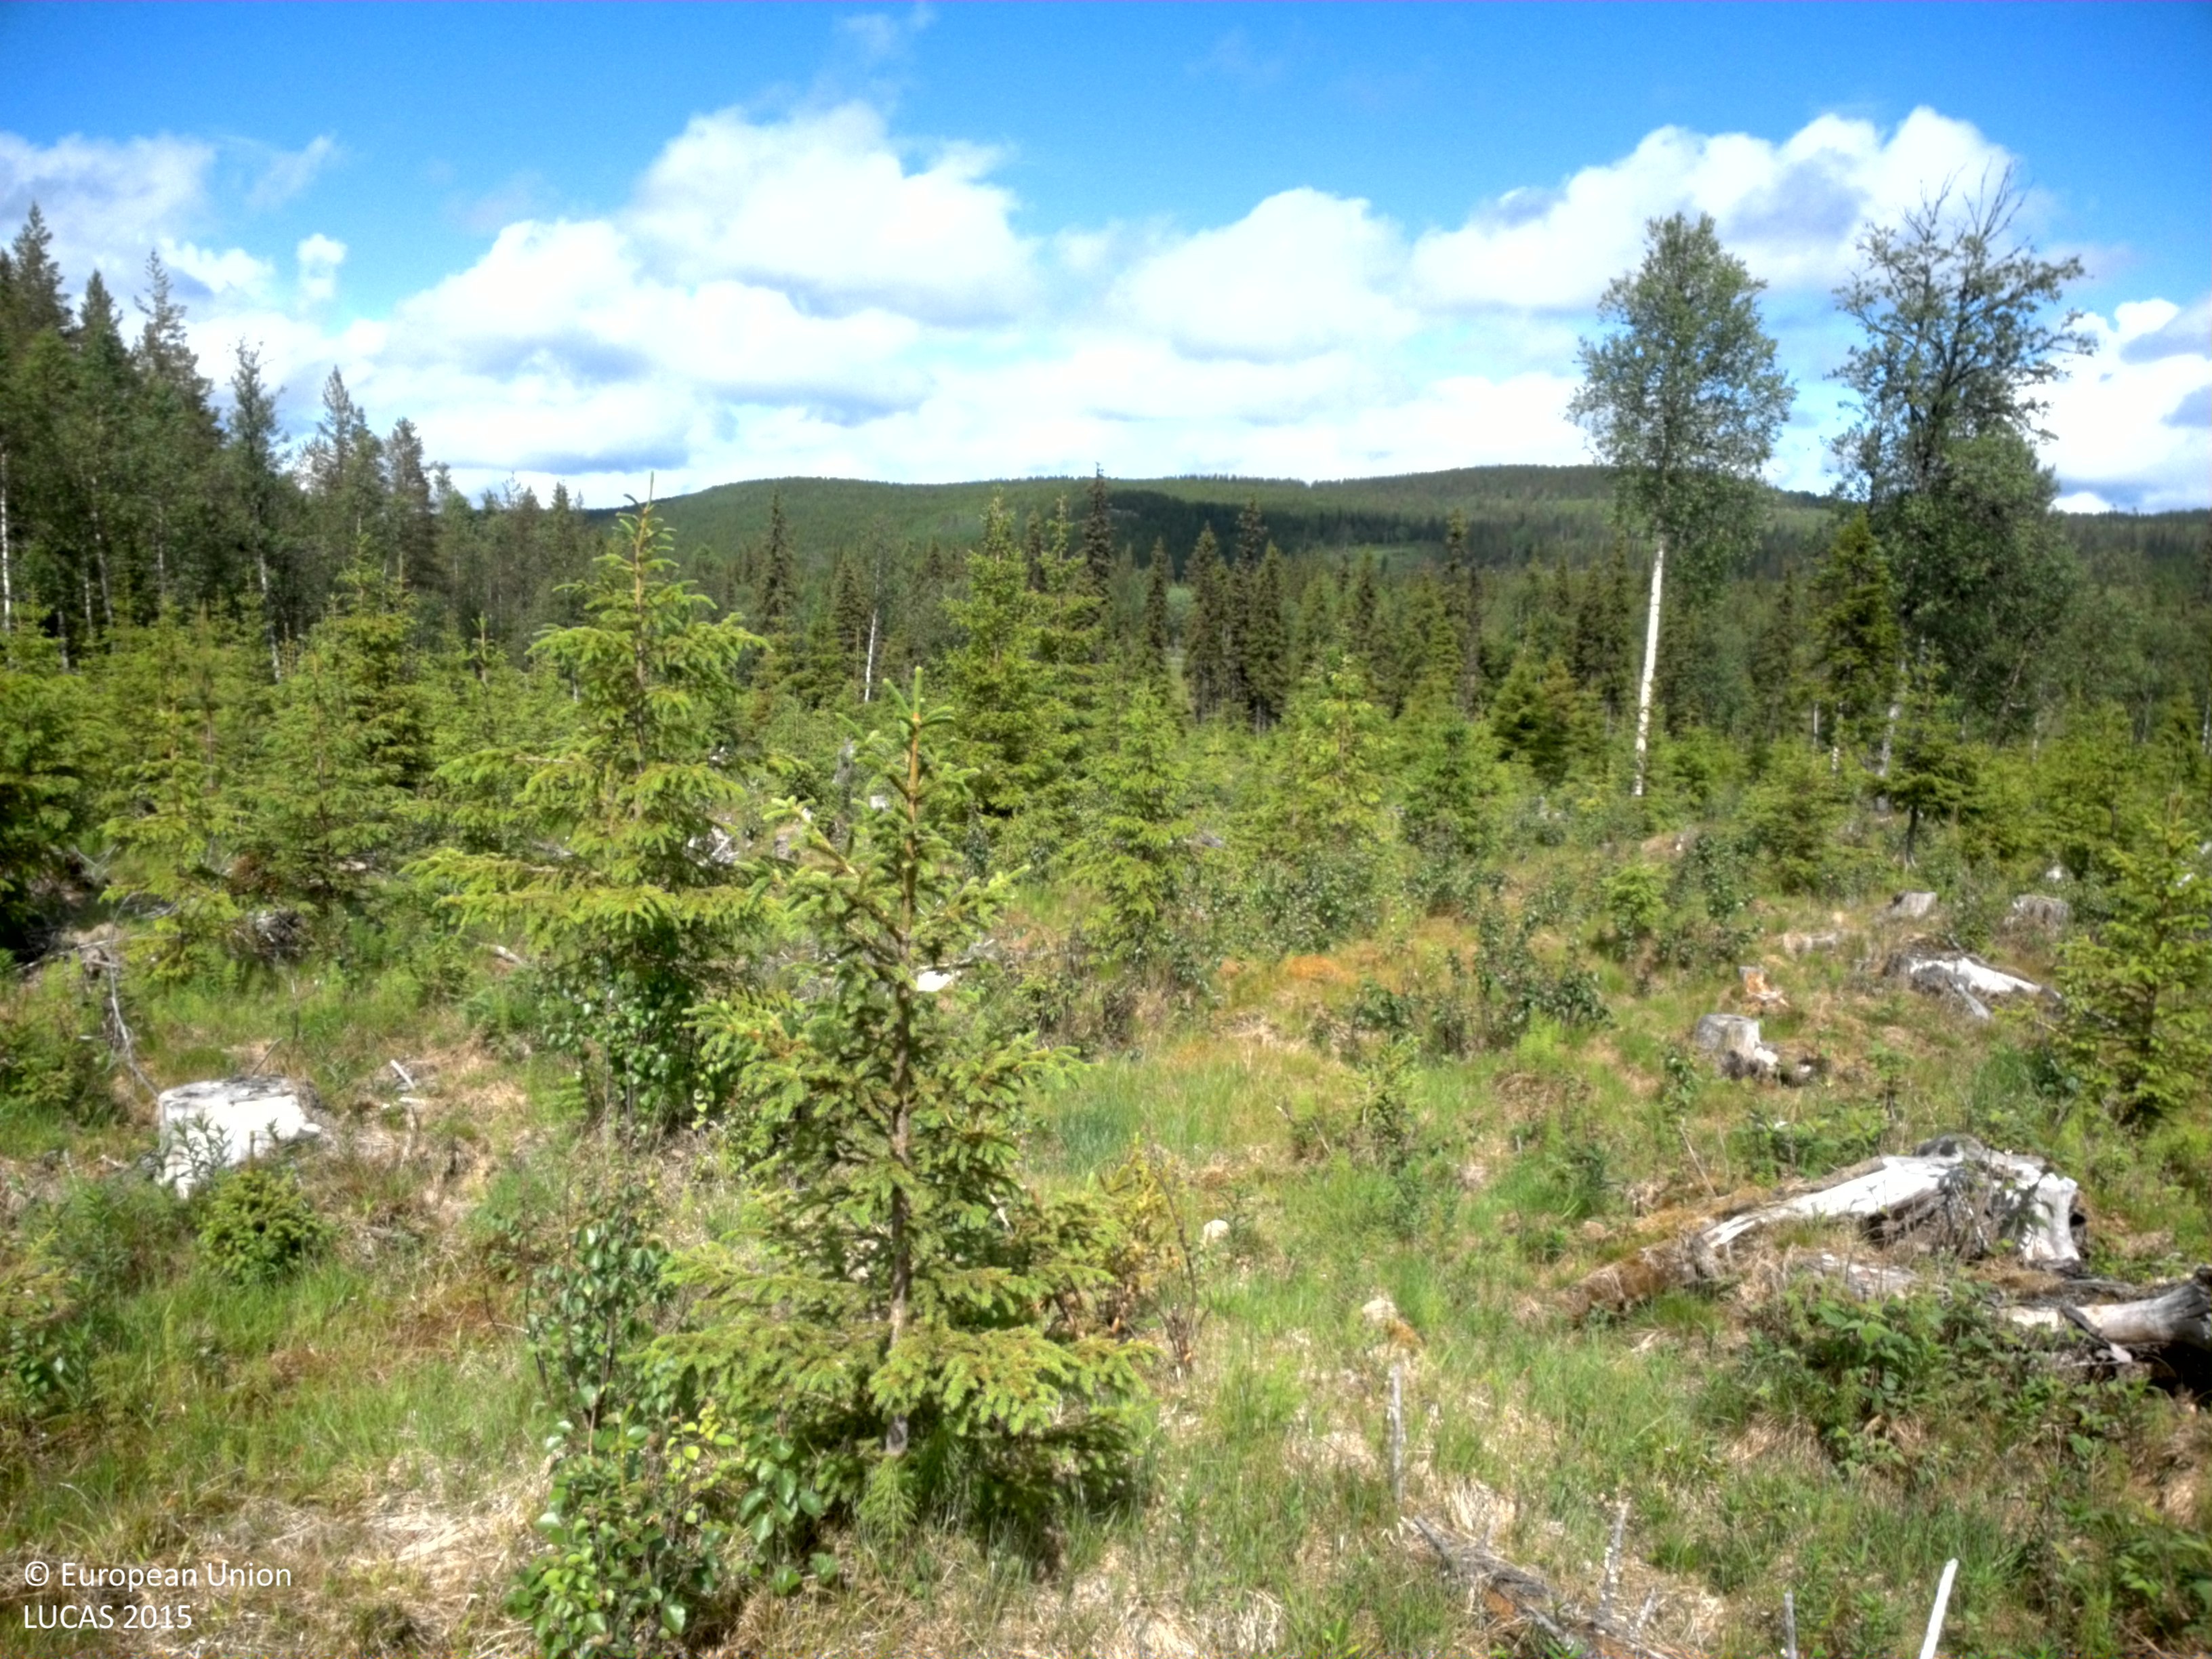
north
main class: Woodland
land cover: Spruce dominated mixed woodland
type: boreal forest
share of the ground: 50 - 75 %
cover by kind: coniferous forest trees 45 %, broadleaved forest trees 30 %, herbaceous plants 20 %, shrubs 5 %
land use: Forestry
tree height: < 5 m
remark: Clear cut
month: July
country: SE
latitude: 64.4796
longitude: 18.1435
